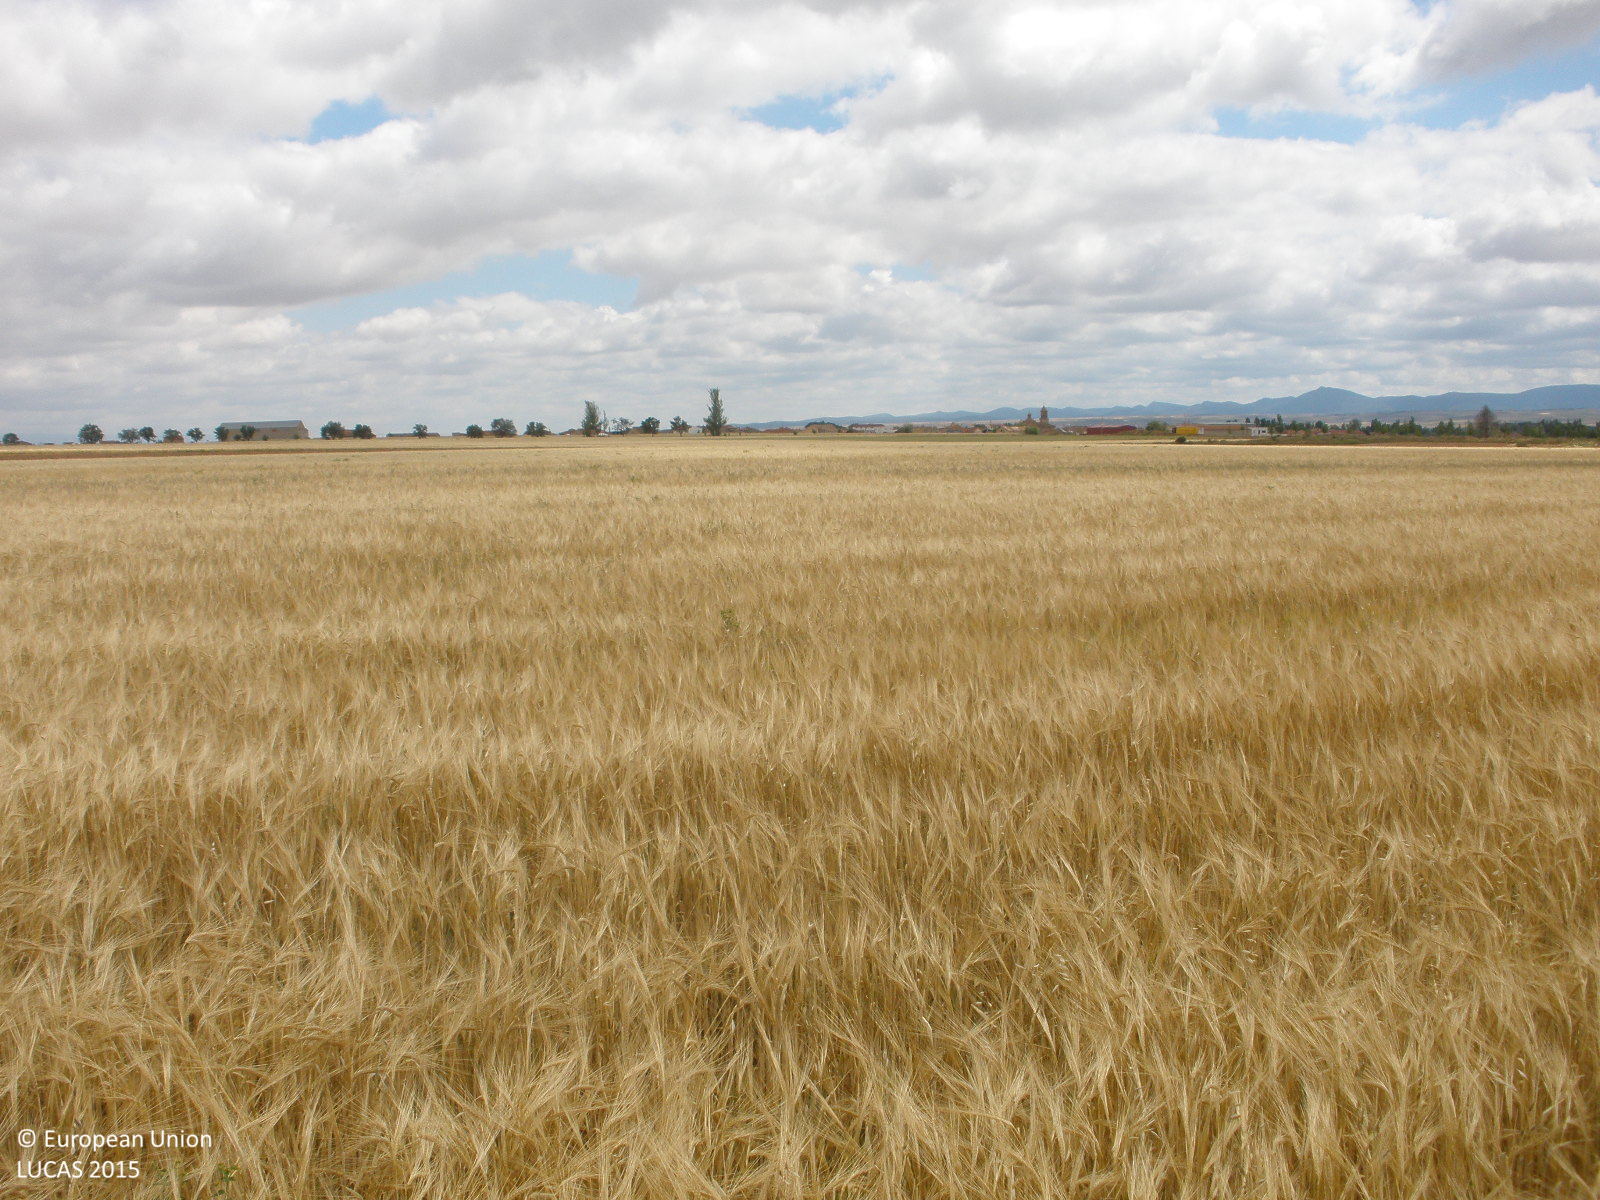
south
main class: Cropland
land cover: Barley
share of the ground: > 75 %
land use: Agriculture (excluding fallow land and kitchen gardens)
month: June
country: ES
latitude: 40.5289
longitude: -1.2637
